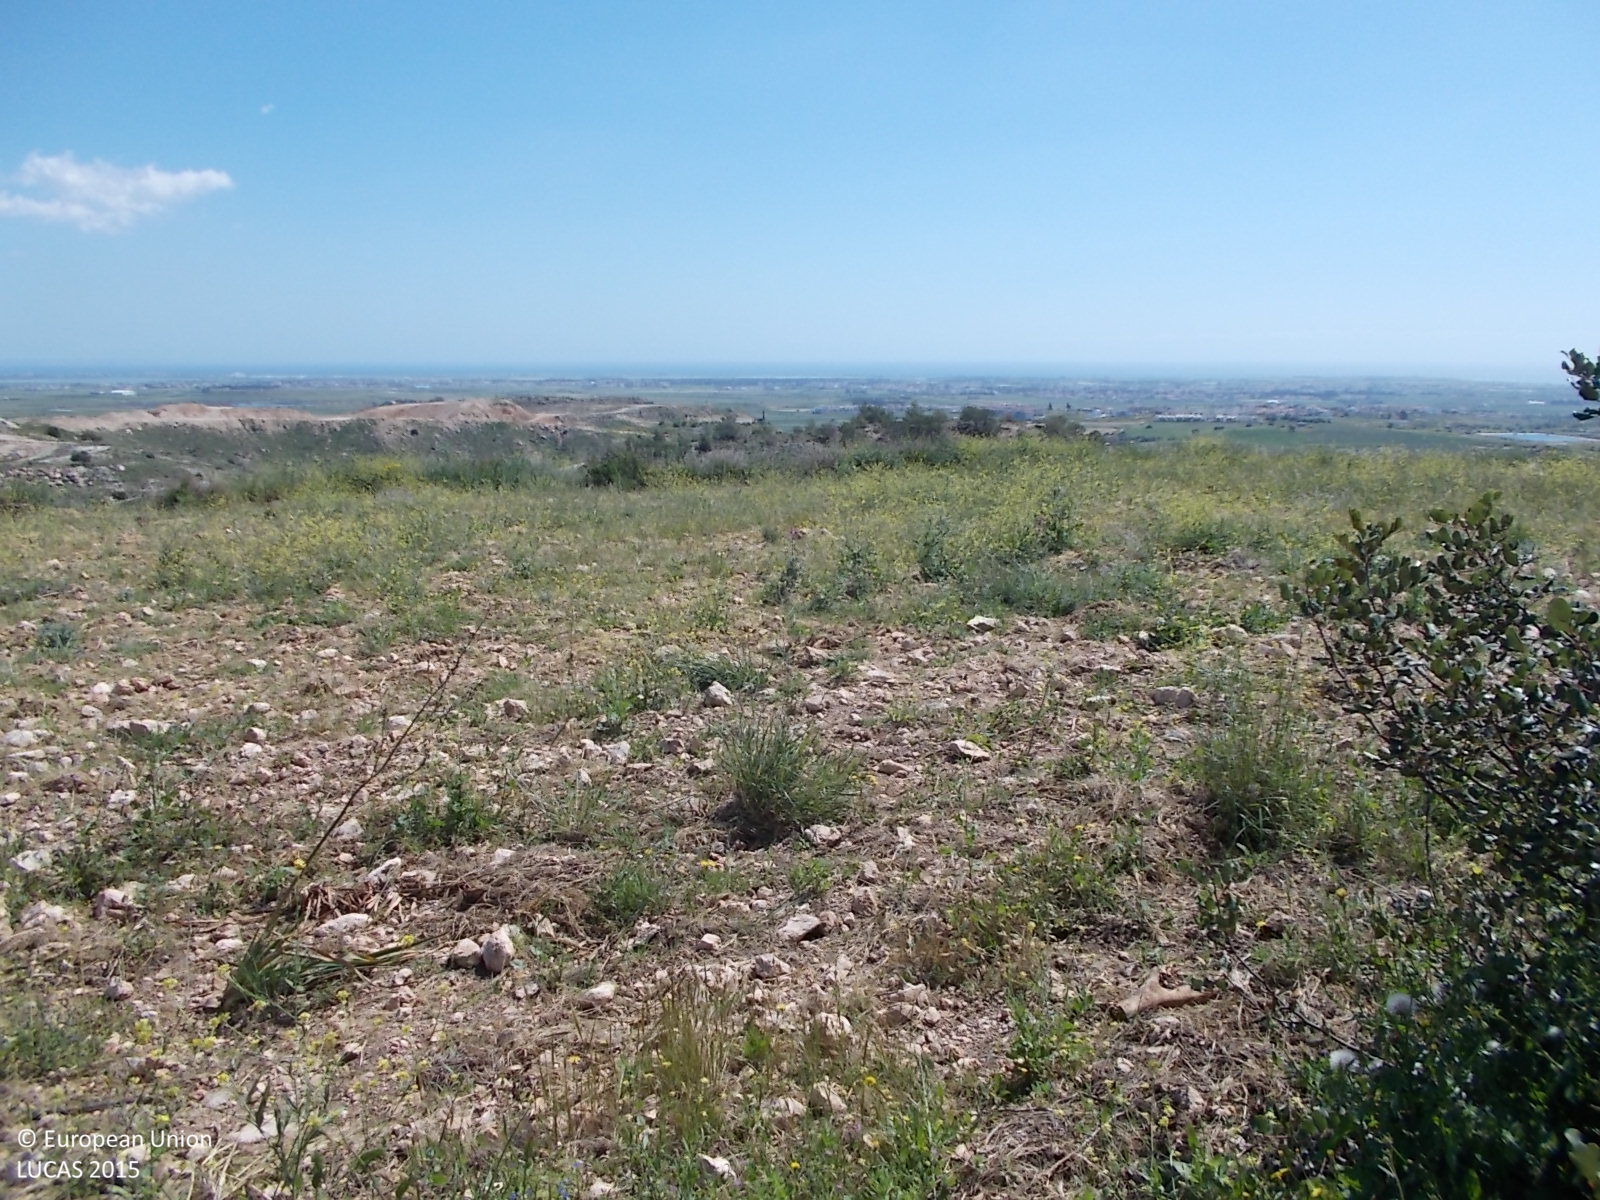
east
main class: Shrubland
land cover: Shrubland without tree cover
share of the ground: 10 - 25 %
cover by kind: unconsolidated bare surface 55 %, herbaceous plants 25 %, shrubs 20 %
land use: Energy production
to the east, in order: Shrubland without tree cover; Grassland without tree/shrub cover; Shrubland without tree cover; Pine dominated coniferous woodland; Tracks; Shrubland without tree cover; Rivers and streams; Shrubland with sparse tree cover; Shrubland without tree cover; Shrubland with sparse tree cover; Tracks; Shrubland without tree cover
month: April
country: CY
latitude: 34.8651
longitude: 33.5228
